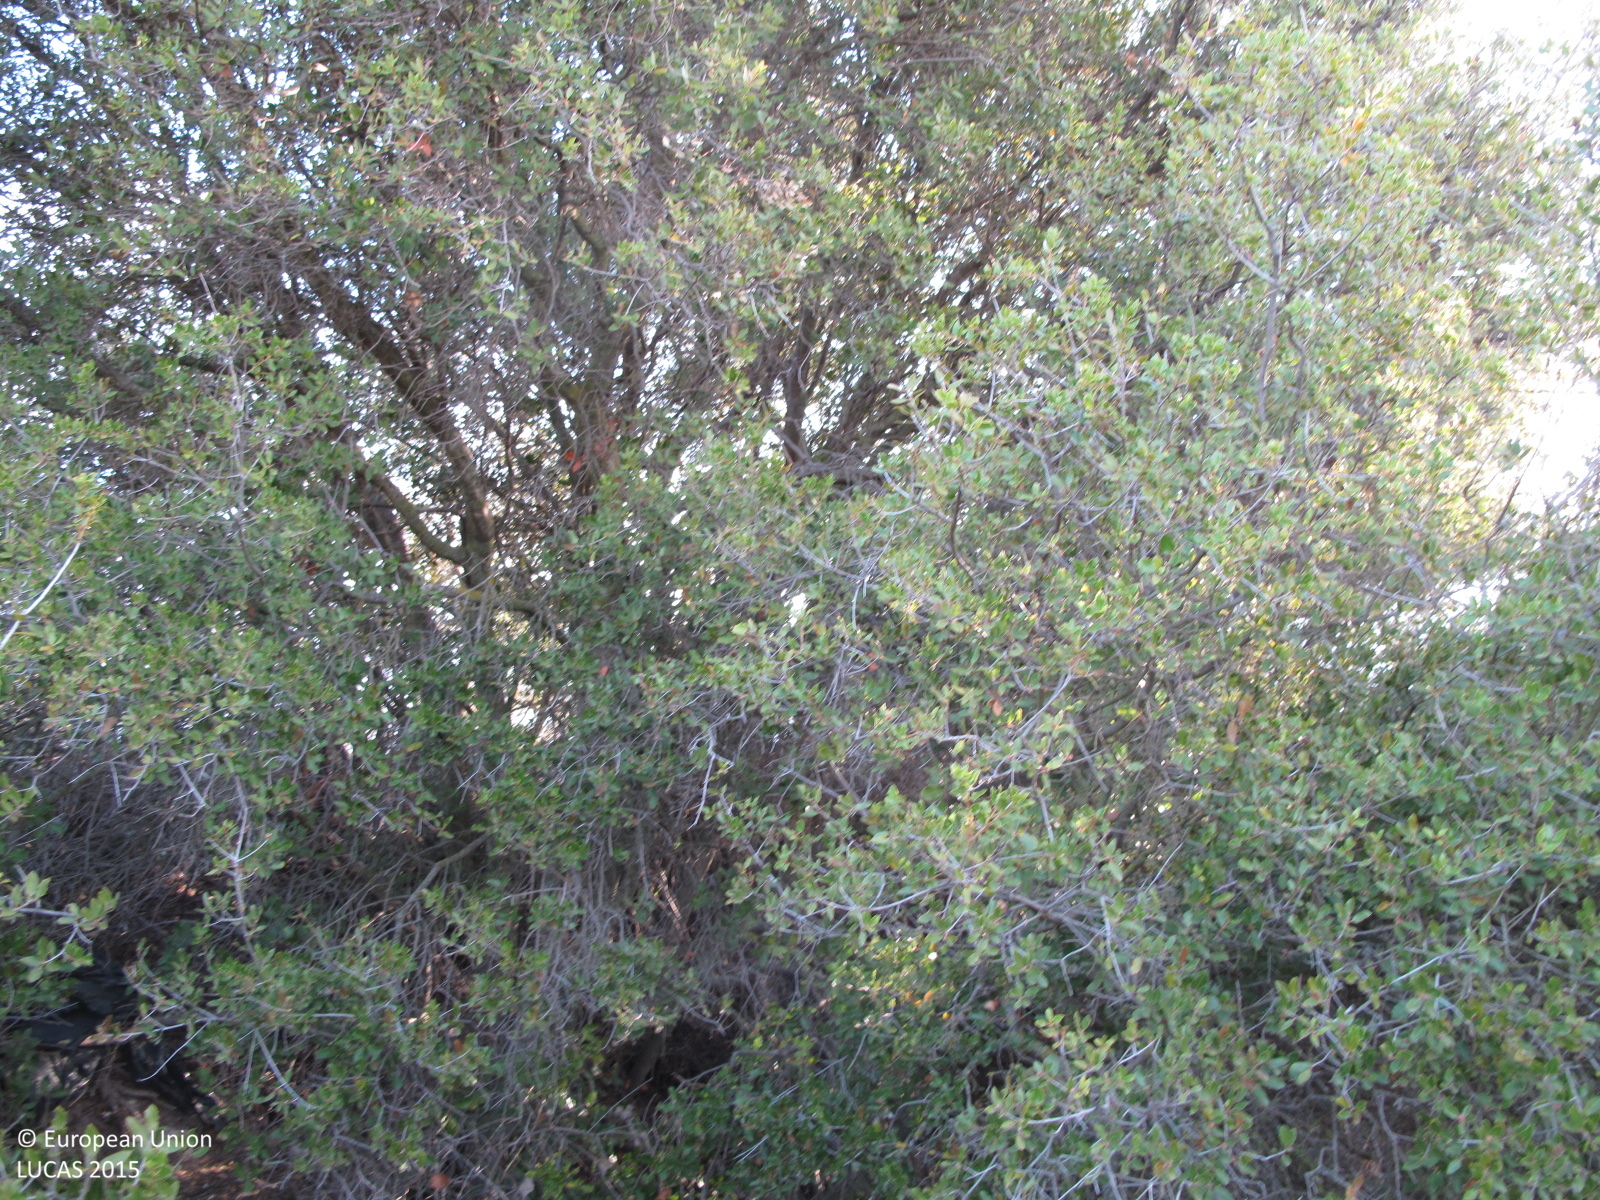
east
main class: Shrubland
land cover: Shrubland with sparse tree cover
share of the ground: > 75 %
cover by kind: shrubs 50 %, herbaceous plants 45 %, broadleaved forest trees 5 %
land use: Semi-natural and natural areas not in use
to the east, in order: Shrubland with sparse tree cover; Olive groves; Shruby margins; Olive groves; Shruby margins; Olive groves; Shruby margins; Dry stone walls; Olive groves; Shruby margins; Olive groves; Shruby margins; Olive groves; Shruby margins; Dry stone walls; Olive groves; Shruby margins; Olive groves; Shruby margins; Olive groves
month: April
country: ES
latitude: 38.5084
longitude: -1.0561
